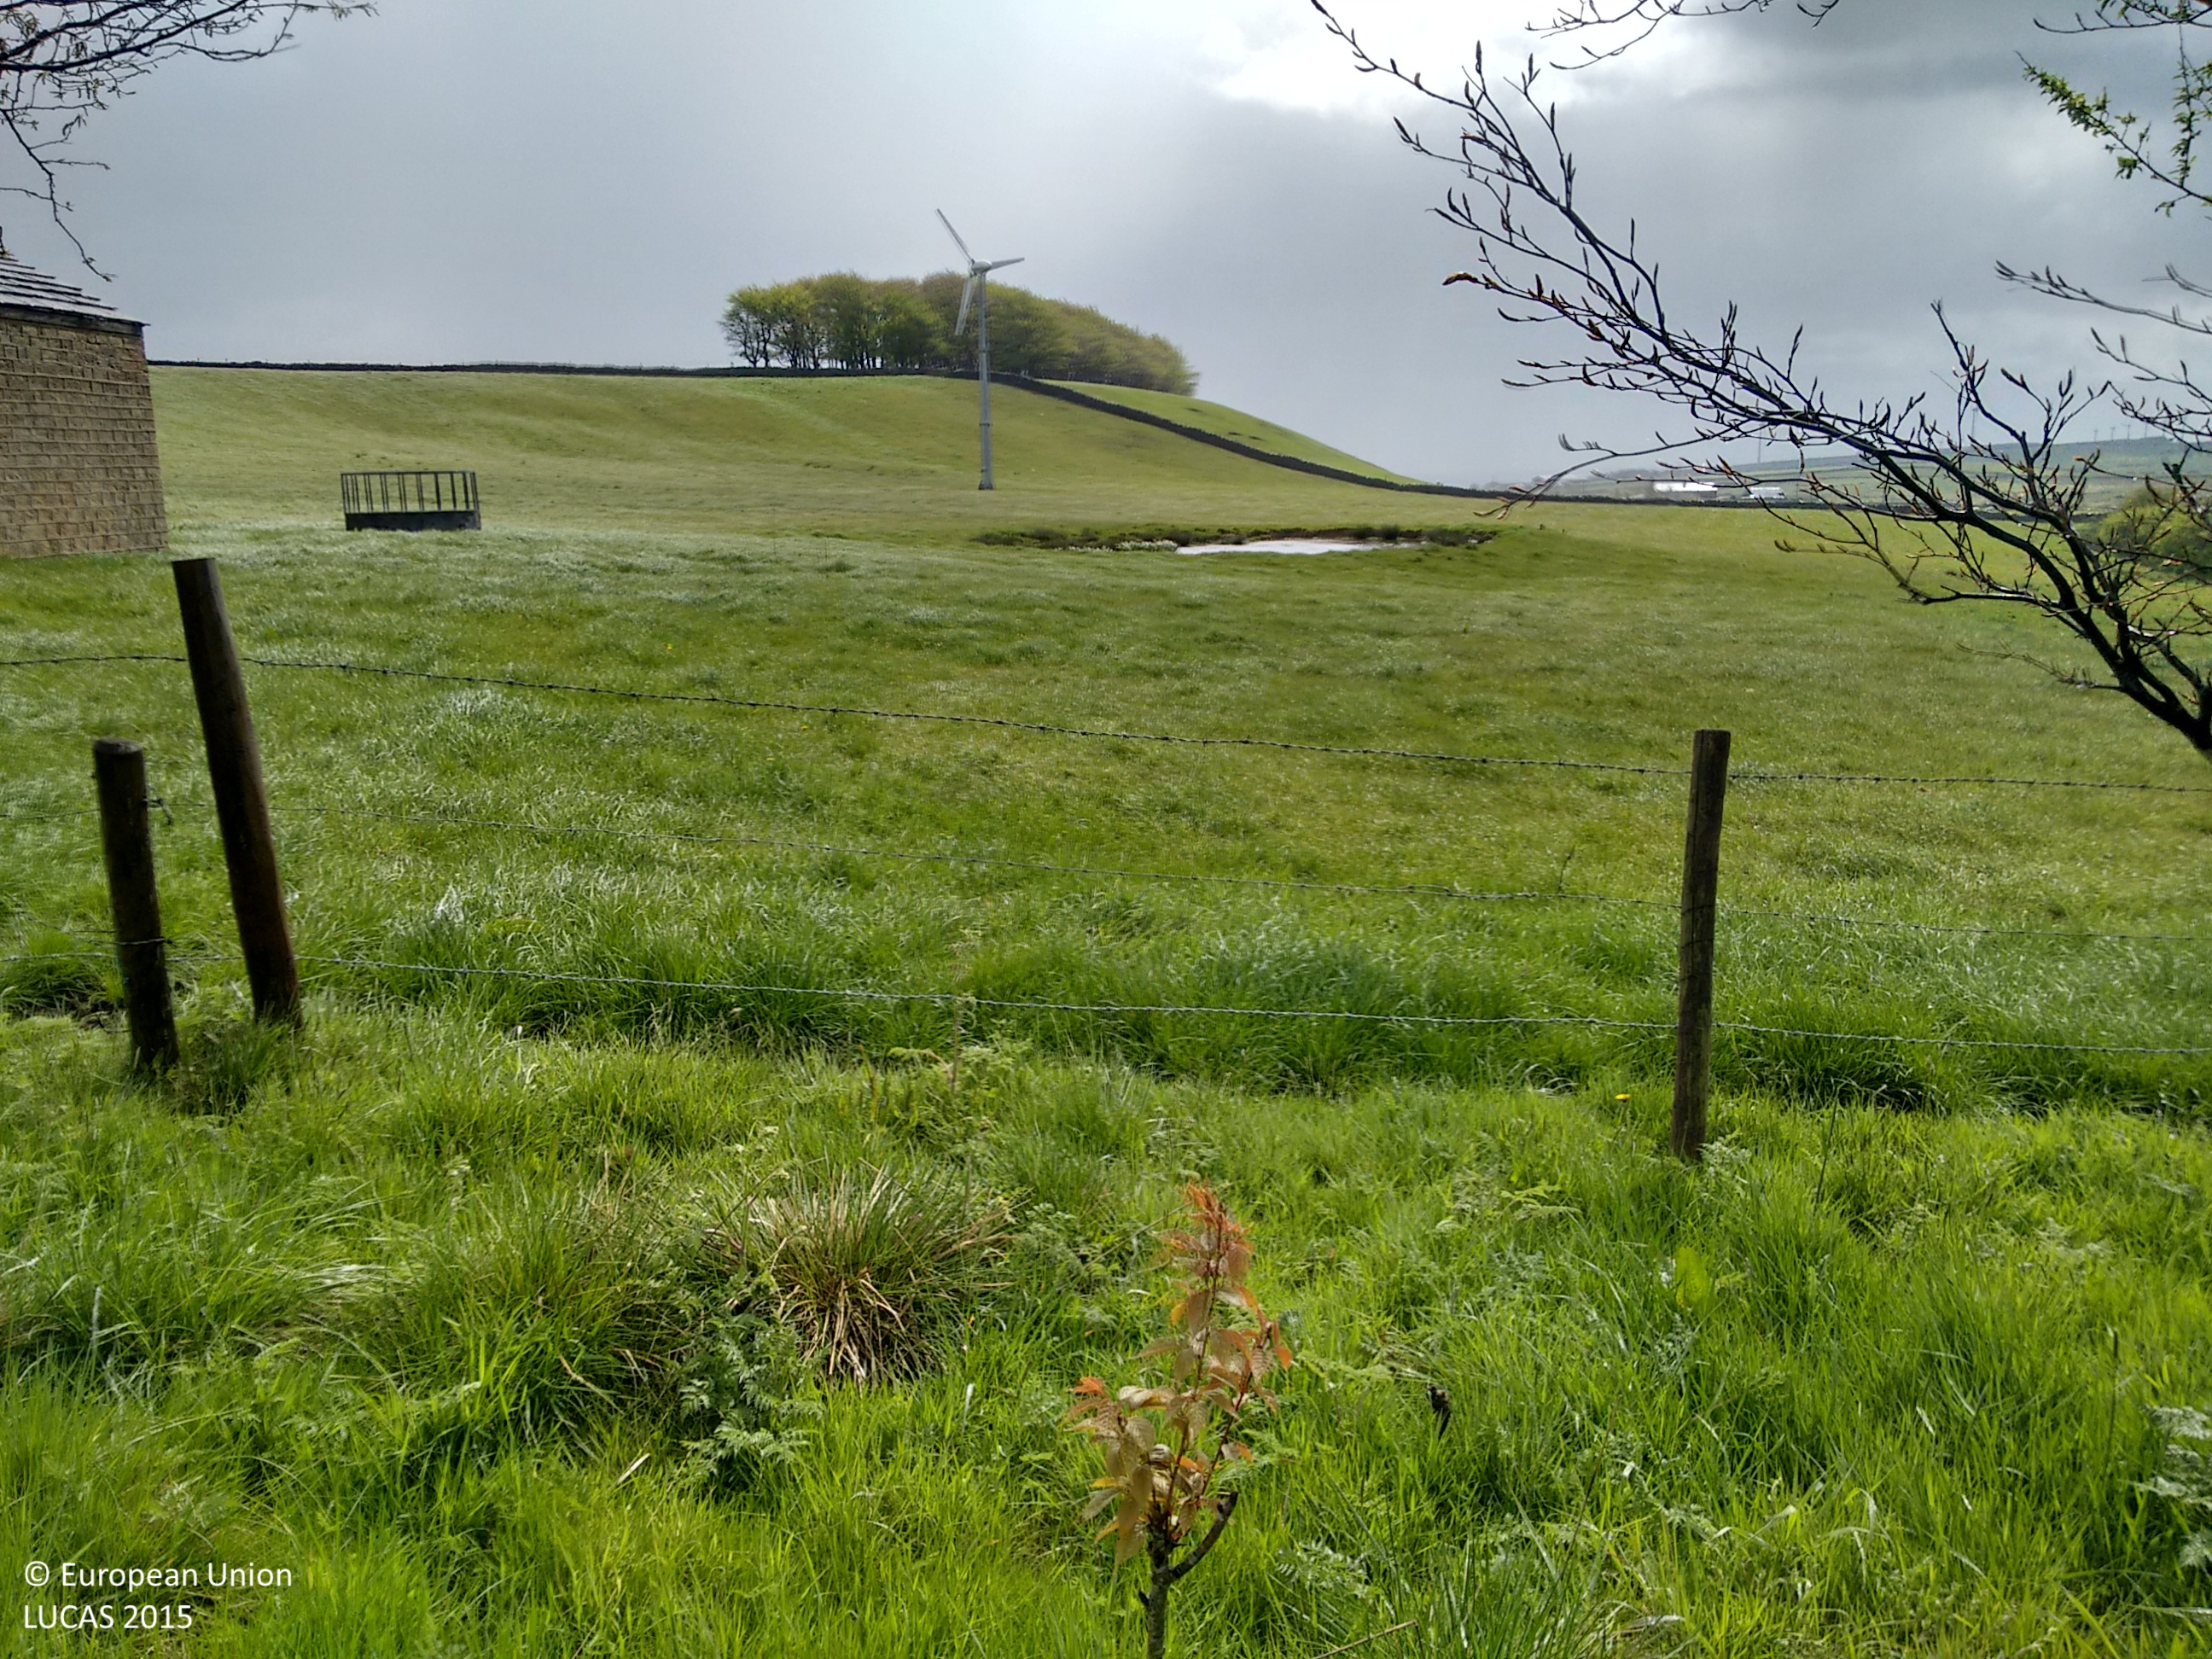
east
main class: Grassland
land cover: Grassland without tree/shrub cover
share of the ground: > 75 %
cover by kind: herbaceous plants 100 %
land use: Agriculture (excluding fallow land and kitchen gardens)
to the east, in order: Grassland without tree/shrub cover; Dry stone walls; Grassland without tree/shrub cover; Dry stone walls; Broadleaved woodland; Grassland without tree/shrub cover; Dry stone walls; Grassland without tree/shrub cover
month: May
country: GB
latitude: 53.5573
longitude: -1.7223
